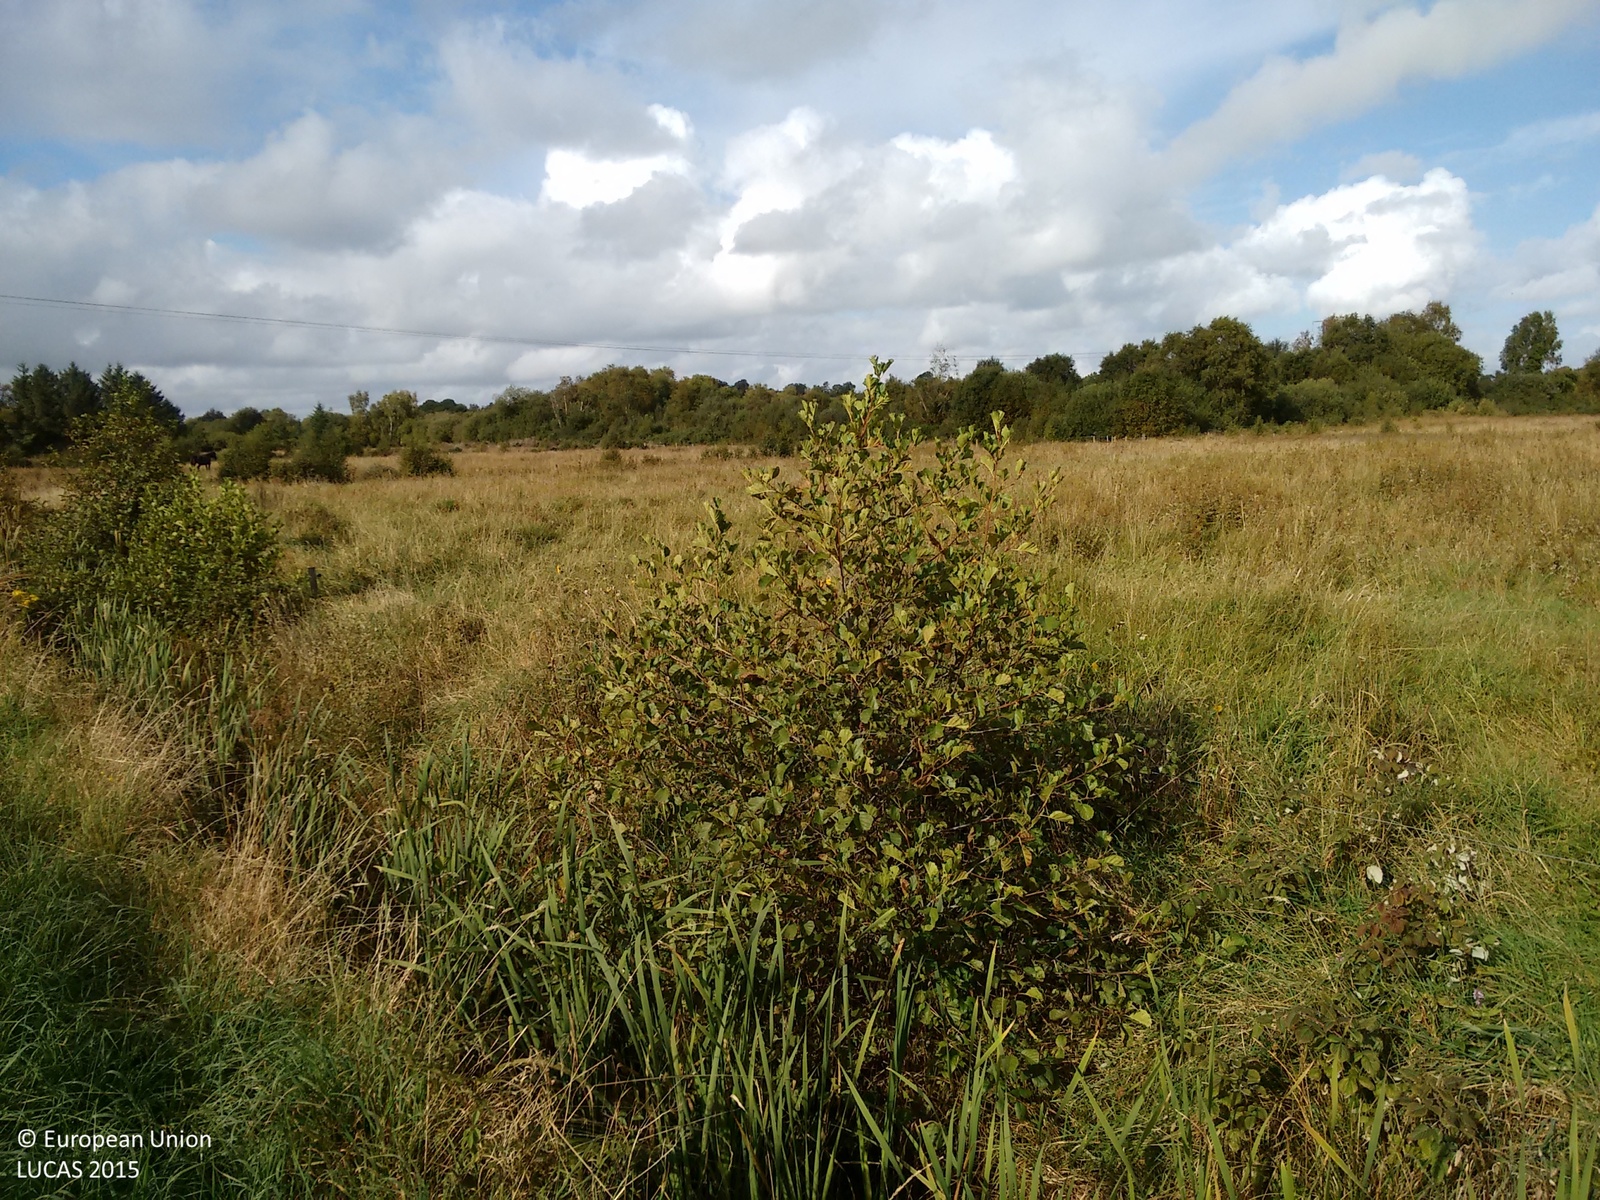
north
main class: Grassland
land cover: Grassland without tree/shrub cover
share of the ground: > 75 %
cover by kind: herbaceous plants 100 %
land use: Agriculture (excluding fallow land and kitchen gardens)
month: October
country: IE
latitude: 53.8358
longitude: -8.0623
